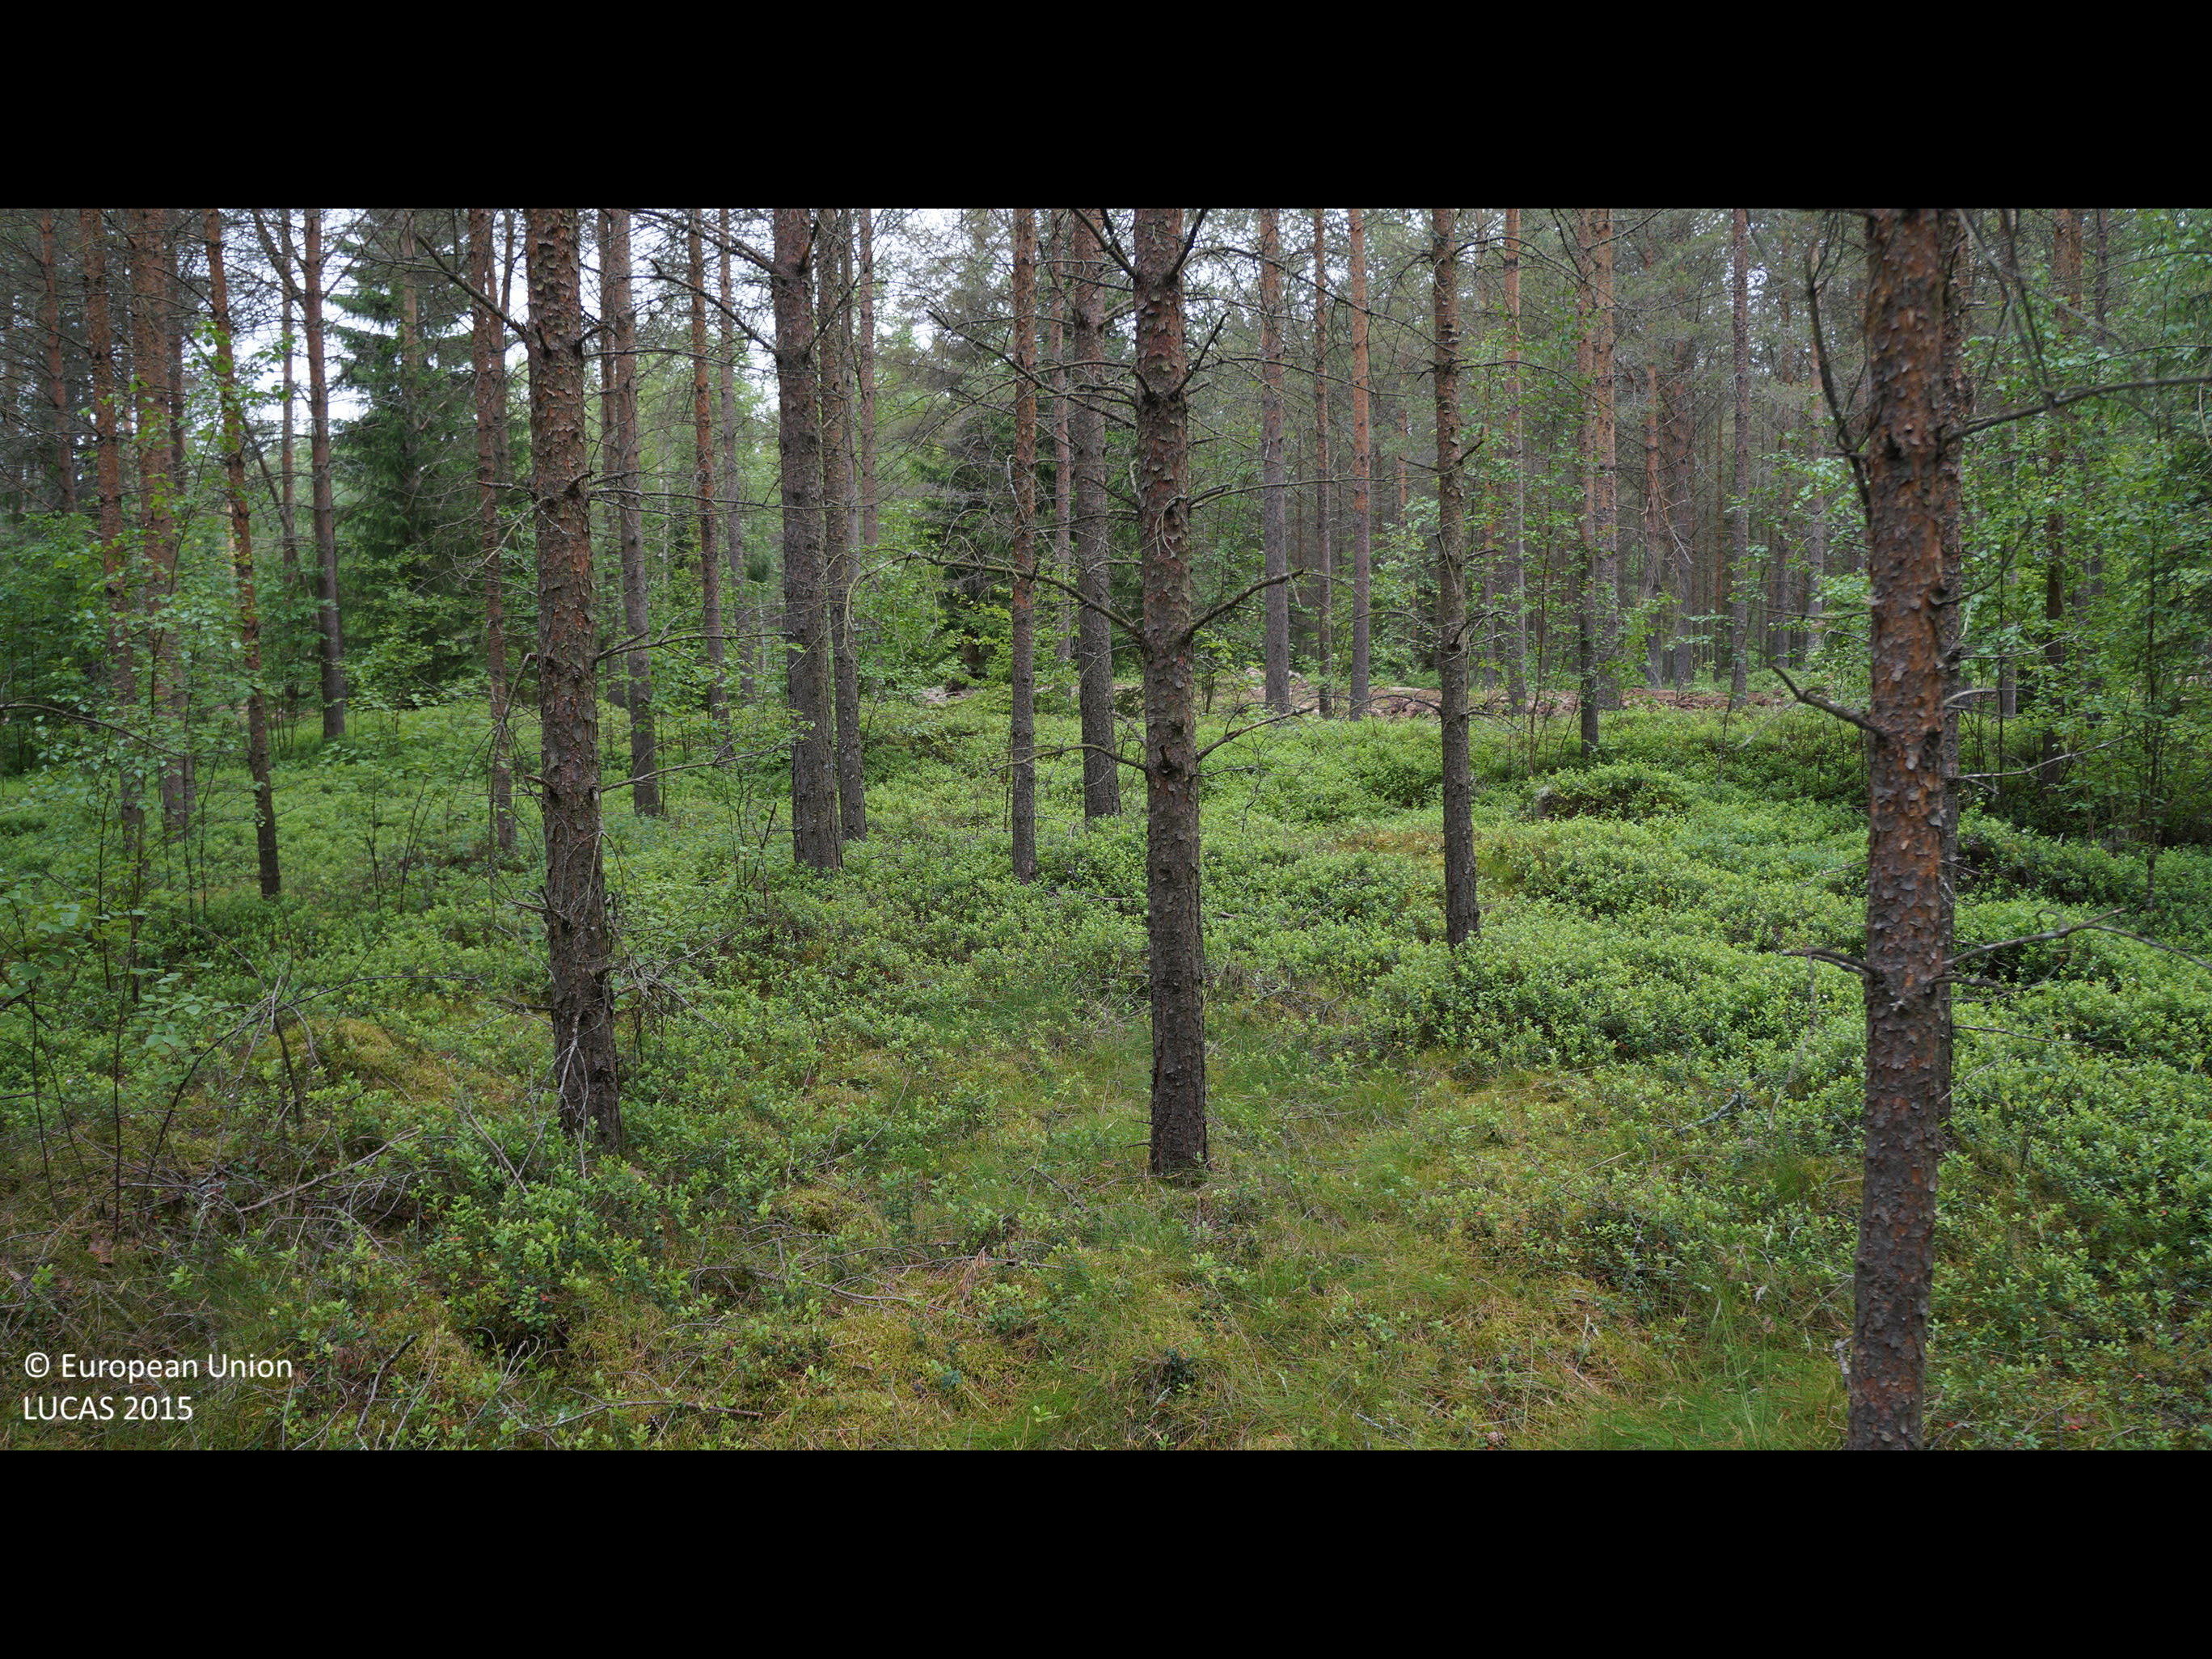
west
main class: Woodland
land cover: Pine dominated coniferous woodland
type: boreal forest
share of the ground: 50 - 75 %
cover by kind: coniferous forest trees 60 %, shrubs 25 %, lichens and mosses 10 %, broadleaved forest trees 5 %
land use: Forestry
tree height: > 5 m
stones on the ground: < 10 %
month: July
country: FI
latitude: 64.0237
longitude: 23.4595
